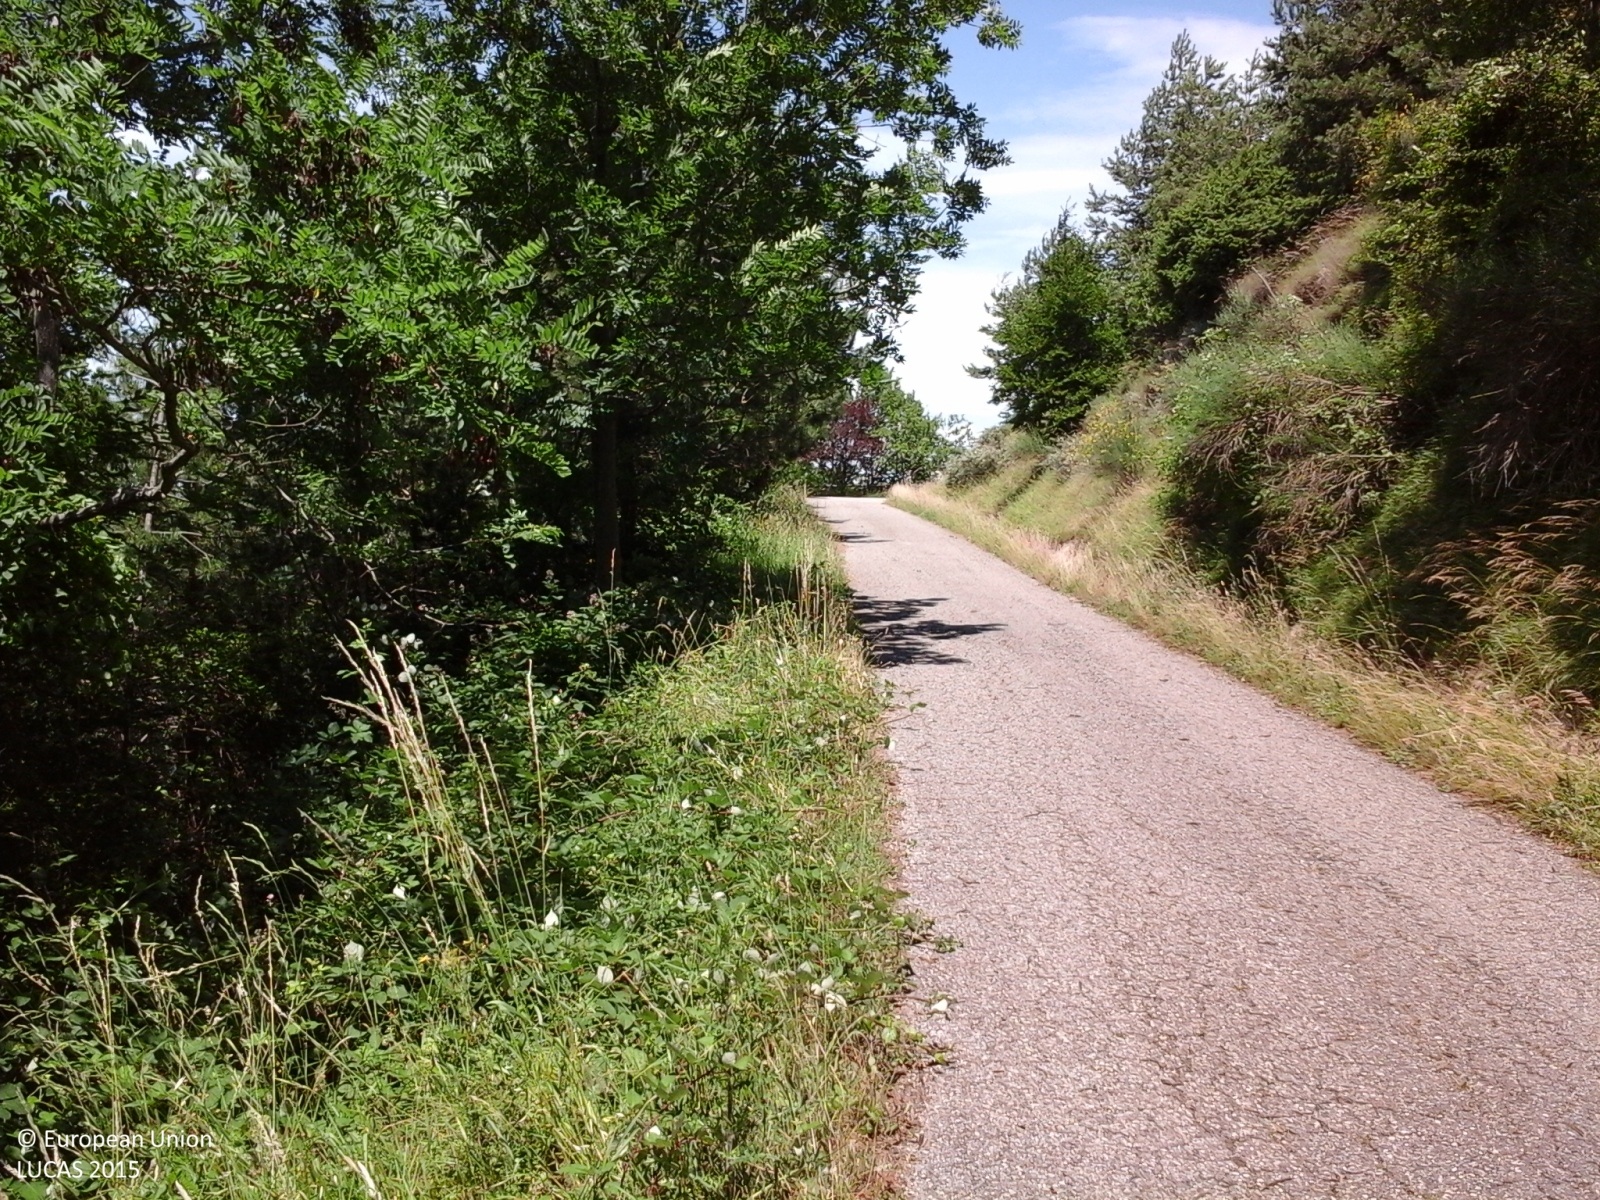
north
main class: Woodland
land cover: Broadleaved woodland
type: acidophilous oak and oak-birch forest
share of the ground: > 75 %
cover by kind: broadleaved forest trees 95 %, shrubs 5 %
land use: Forestry
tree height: > 5 m
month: June
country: IT
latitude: 44.2302
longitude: 11.5863
